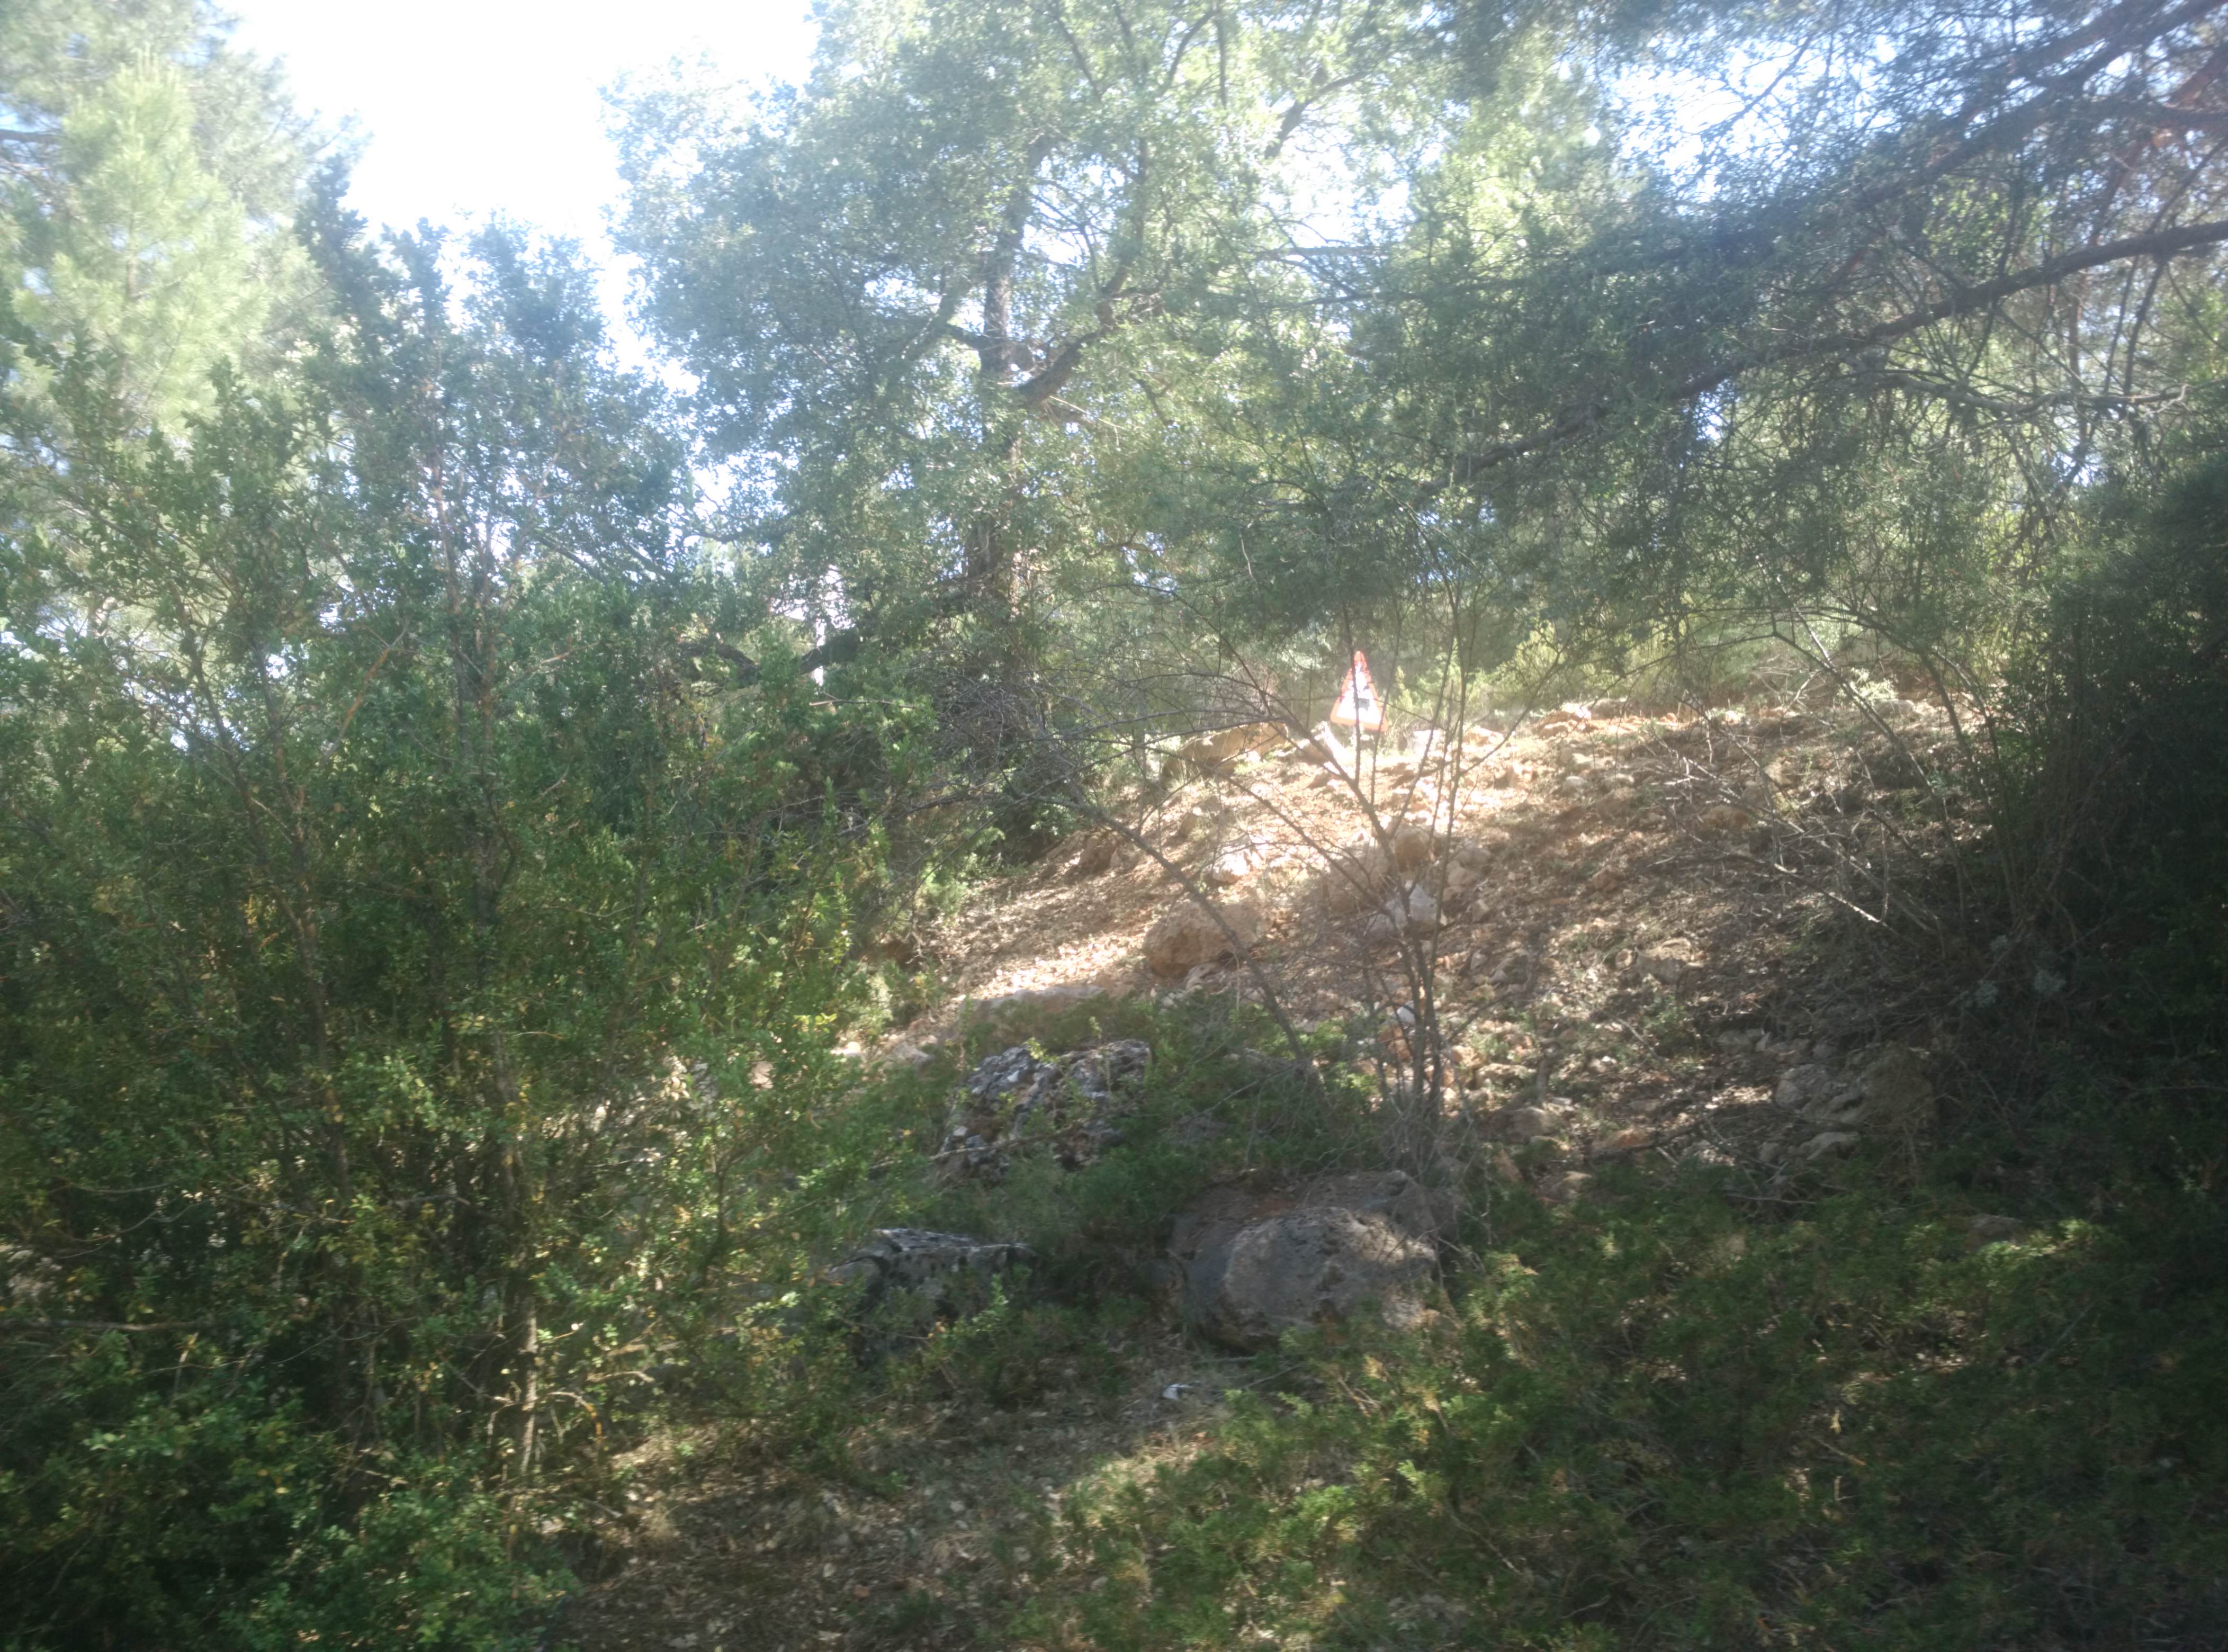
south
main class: Woodland
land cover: Pine dominated coniferous woodland
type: coniferous forest of the mediterranean region
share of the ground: 25 - 50 %
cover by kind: coniferous forest trees 40 %, unconsolidated bare surface 40 %, shrubs 15 %, herbaceous plants 5 %
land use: Semi-natural and natural areas not in use
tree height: > 5 m
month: June
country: ES
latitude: 40.6264
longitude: -1.8295
